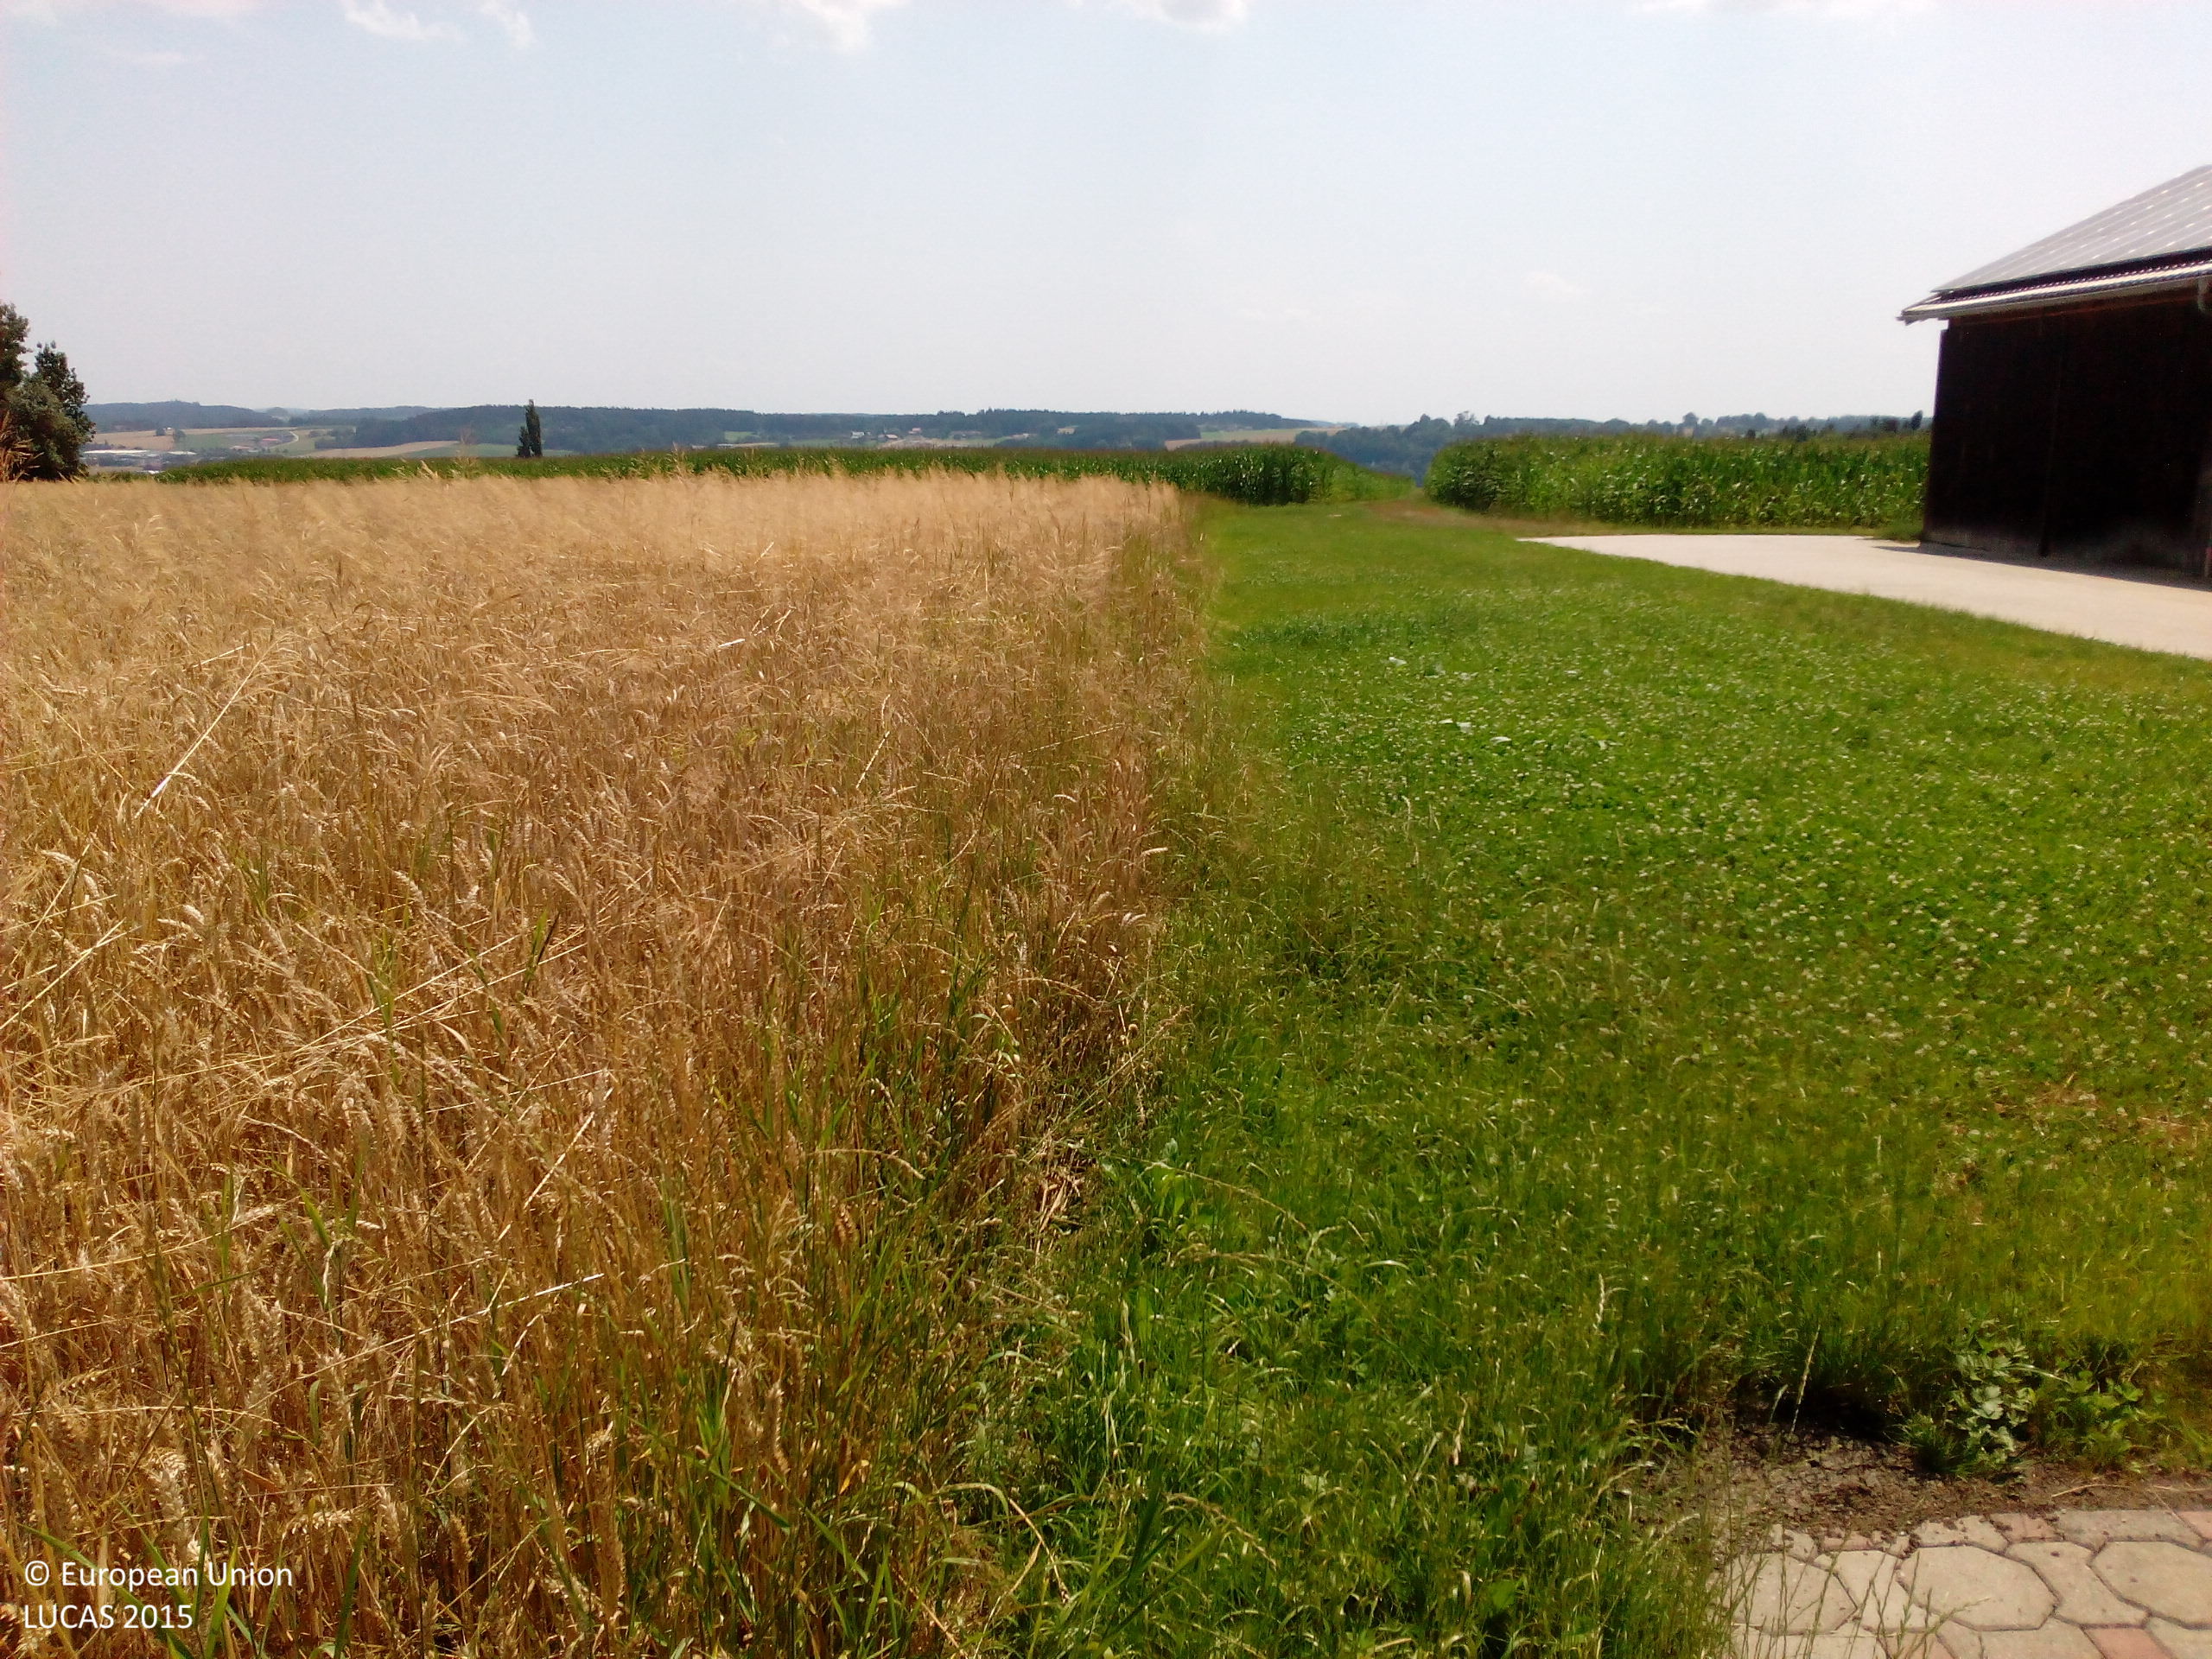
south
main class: Cropland
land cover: Common wheat
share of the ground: > 75 %
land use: Agriculture (excluding fallow land and kitchen gardens)
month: July
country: DE
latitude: 48.4374
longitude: 12.9054
